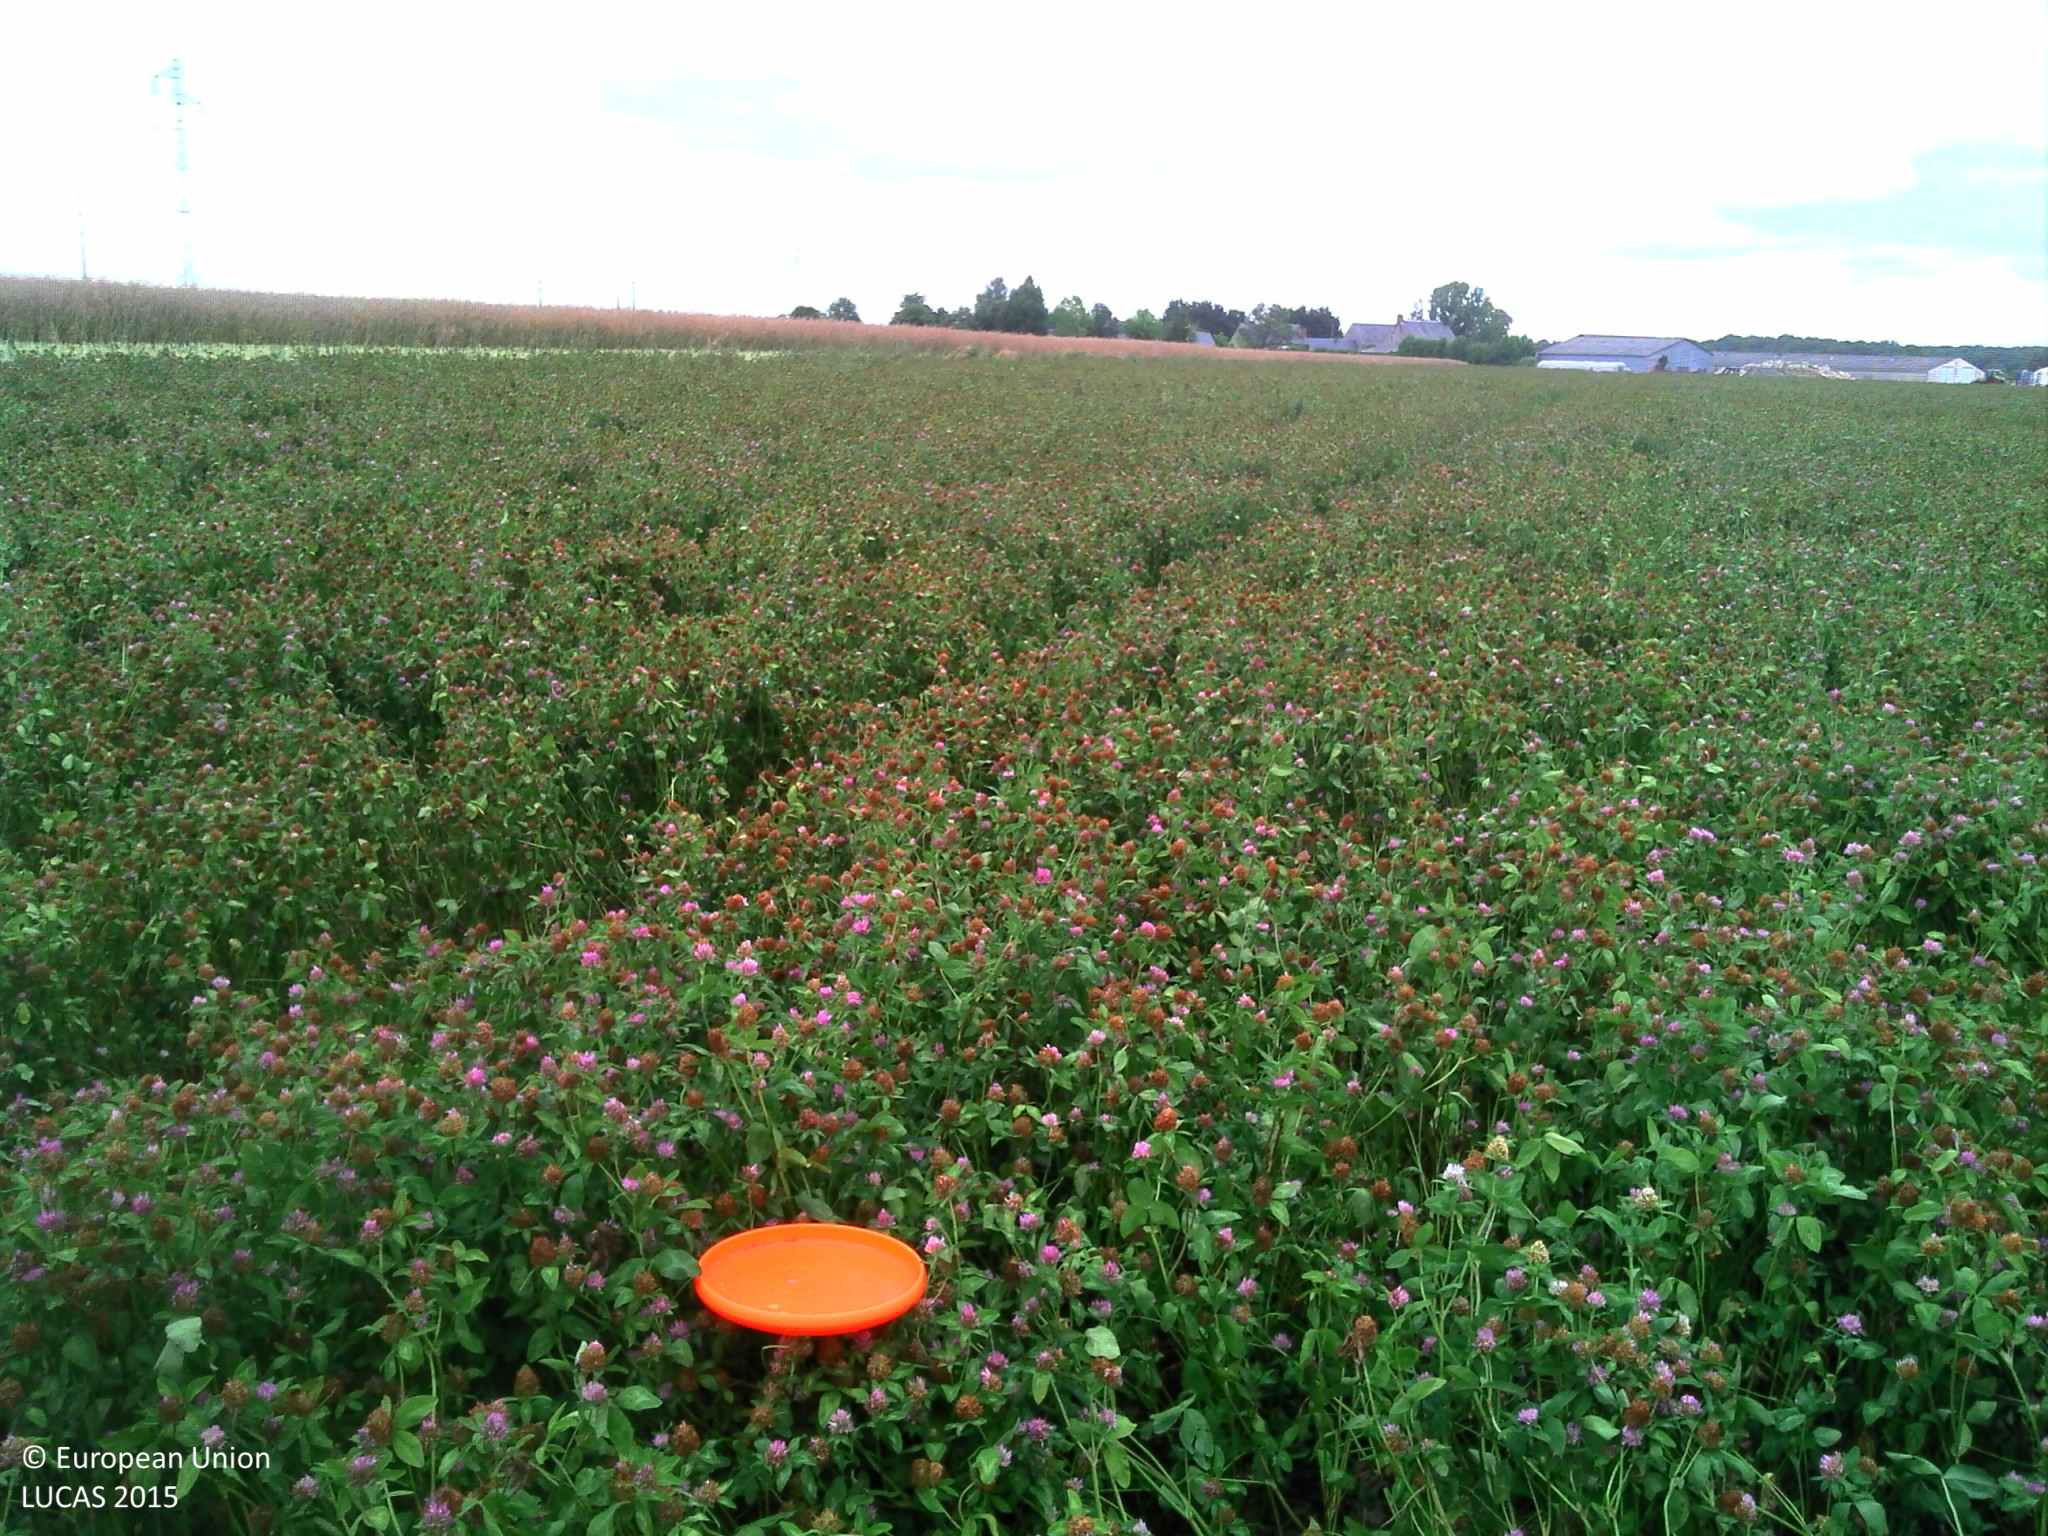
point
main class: Cropland
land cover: Clovers
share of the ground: > 75 %
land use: Agriculture (excluding fallow land and kitchen gardens)
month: July
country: FR
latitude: 47.2516
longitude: 0.7189
